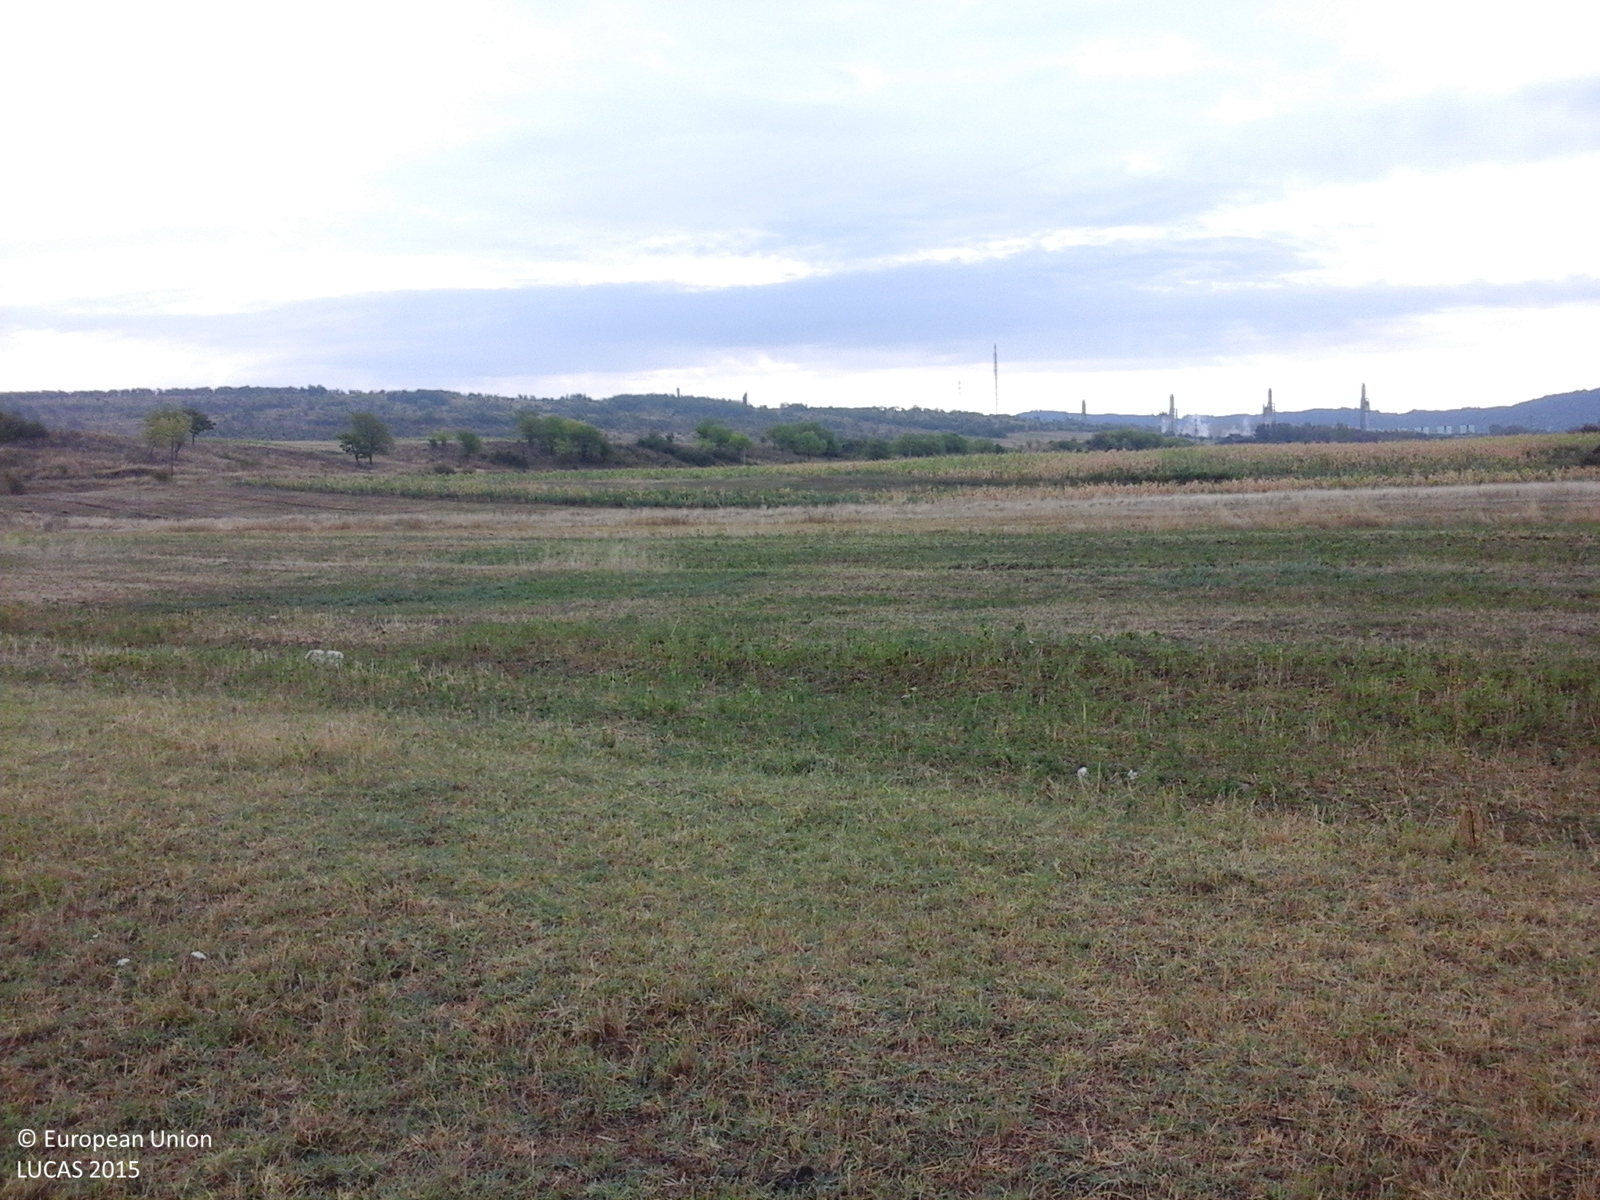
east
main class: Grassland
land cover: Grassland without tree/shrub cover
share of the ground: > 75 %
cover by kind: herbaceous plants 100 %
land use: Agriculture (excluding fallow land and kitchen gardens)
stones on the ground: < 10 %
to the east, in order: Grassland without tree/shrub cover; Lines of trees; Grassland without tree/shrub cover; Common wheat; Grassland without tree/shrub cover; Maize; Grassland without tree/shrub cover; Maize
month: August
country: RO
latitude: 44.7005
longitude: 22.6752
